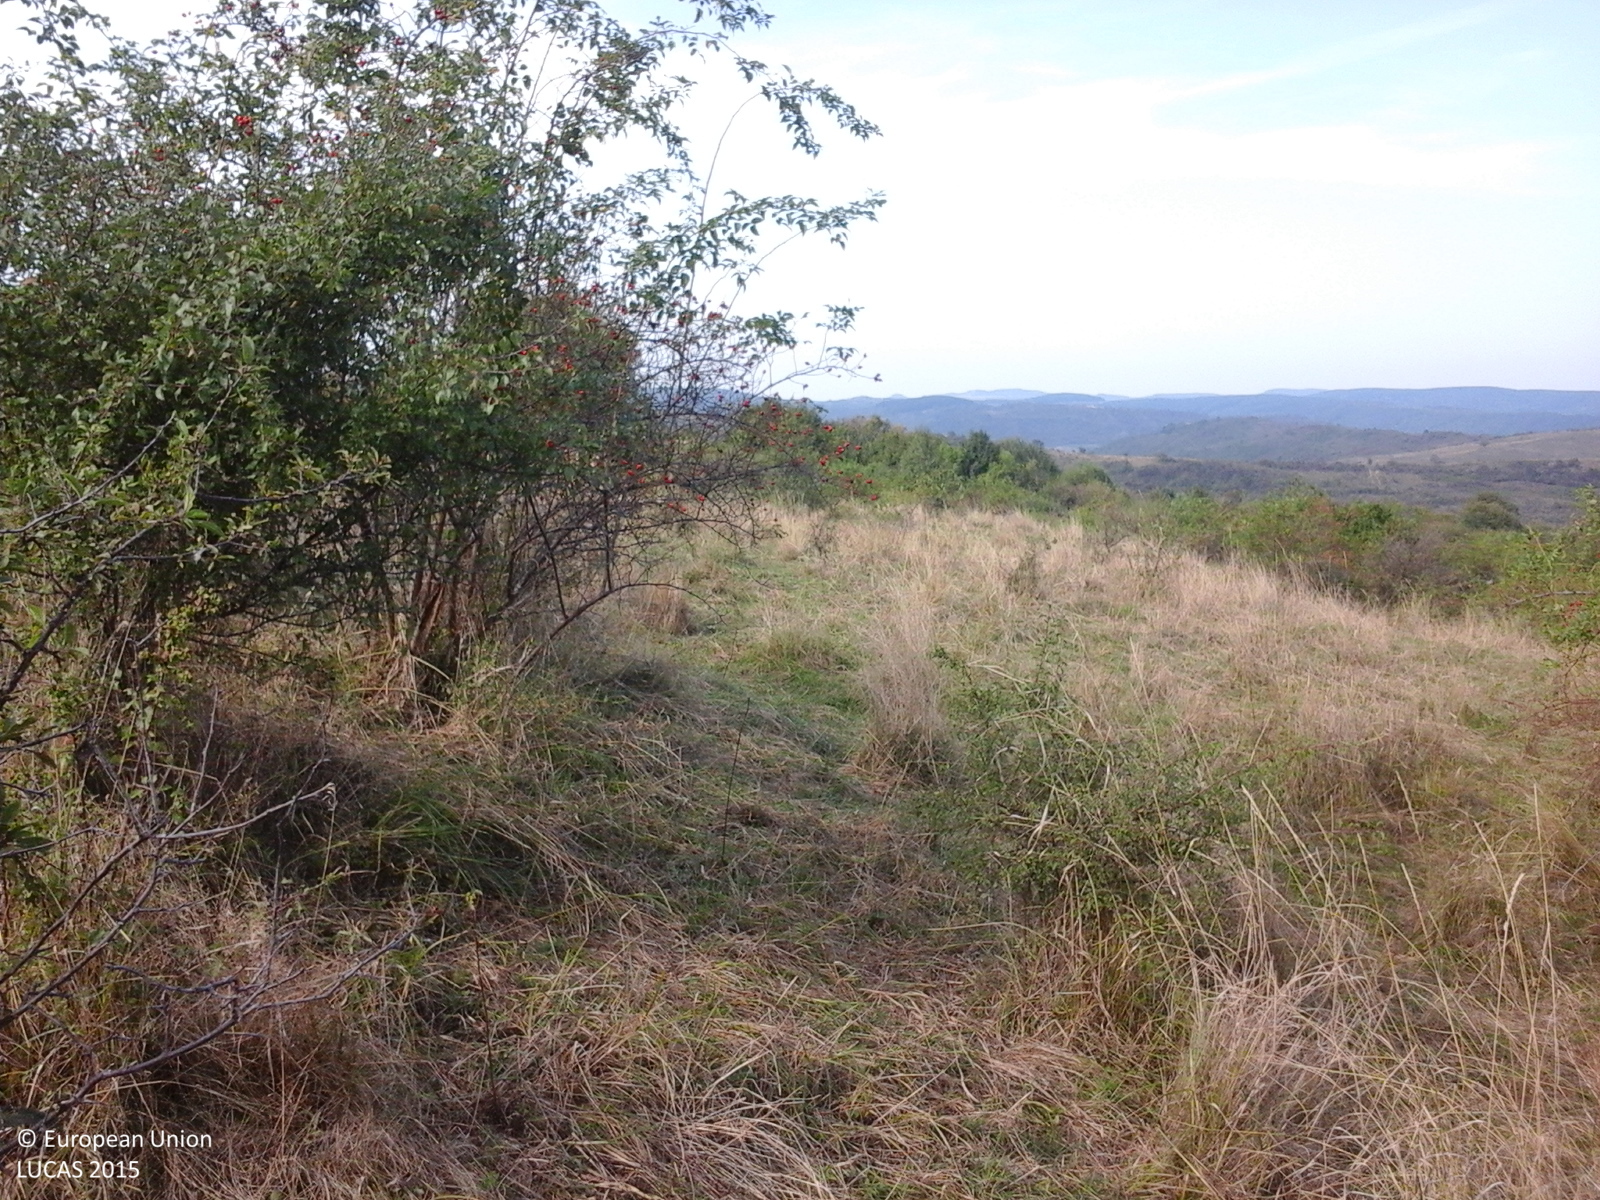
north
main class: Grassland
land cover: Grassland with sparse tree/shrub cover
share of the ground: > 75 %
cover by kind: herbaceous plants 85 %, shrubs 10 %, broadleaved forest trees 5 %
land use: Agriculture (excluding fallow land and kitchen gardens)
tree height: < 5 m
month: September
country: RO
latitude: 47.1125
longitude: 23.6618
